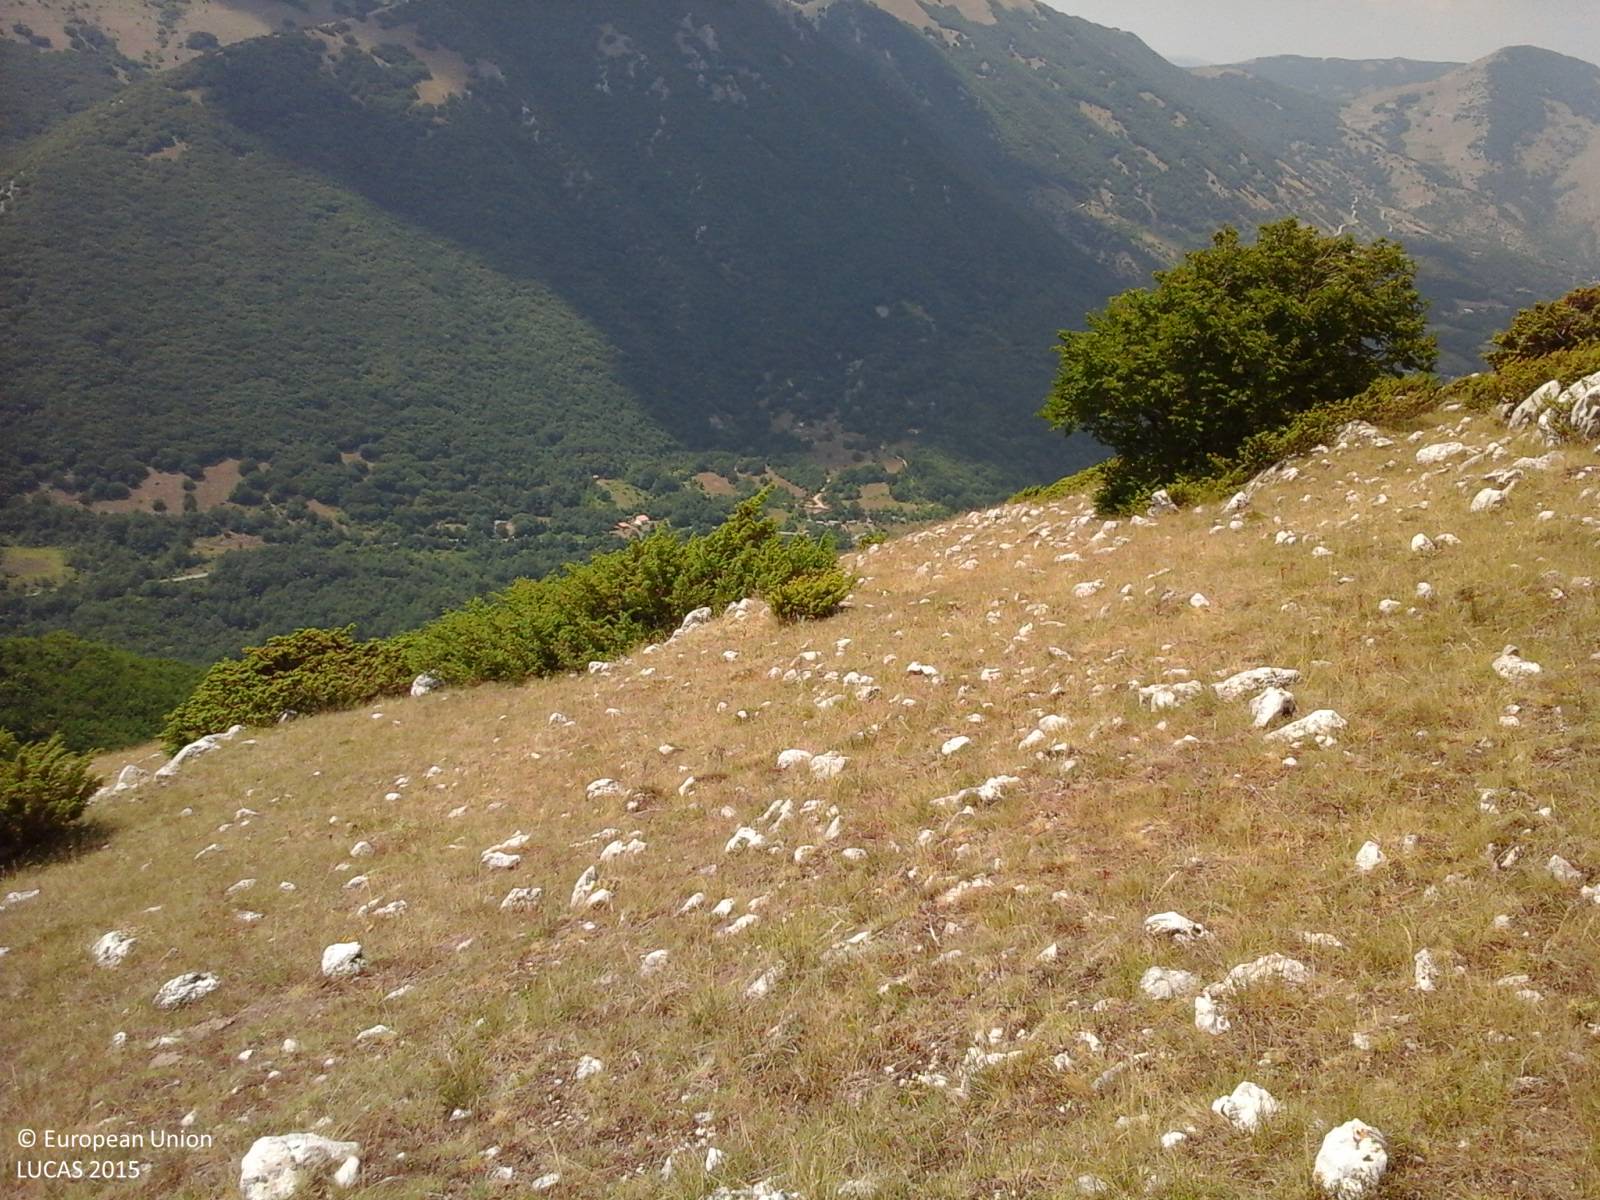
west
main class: Grassland
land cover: Grassland without tree/shrub cover
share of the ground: > 75 %
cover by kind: herbaceous plants 60 %, consolidated bare surface 40 %
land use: Agriculture (excluding fallow land and kitchen gardens)
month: July
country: IT
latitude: 42.2741
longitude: 13.3234
